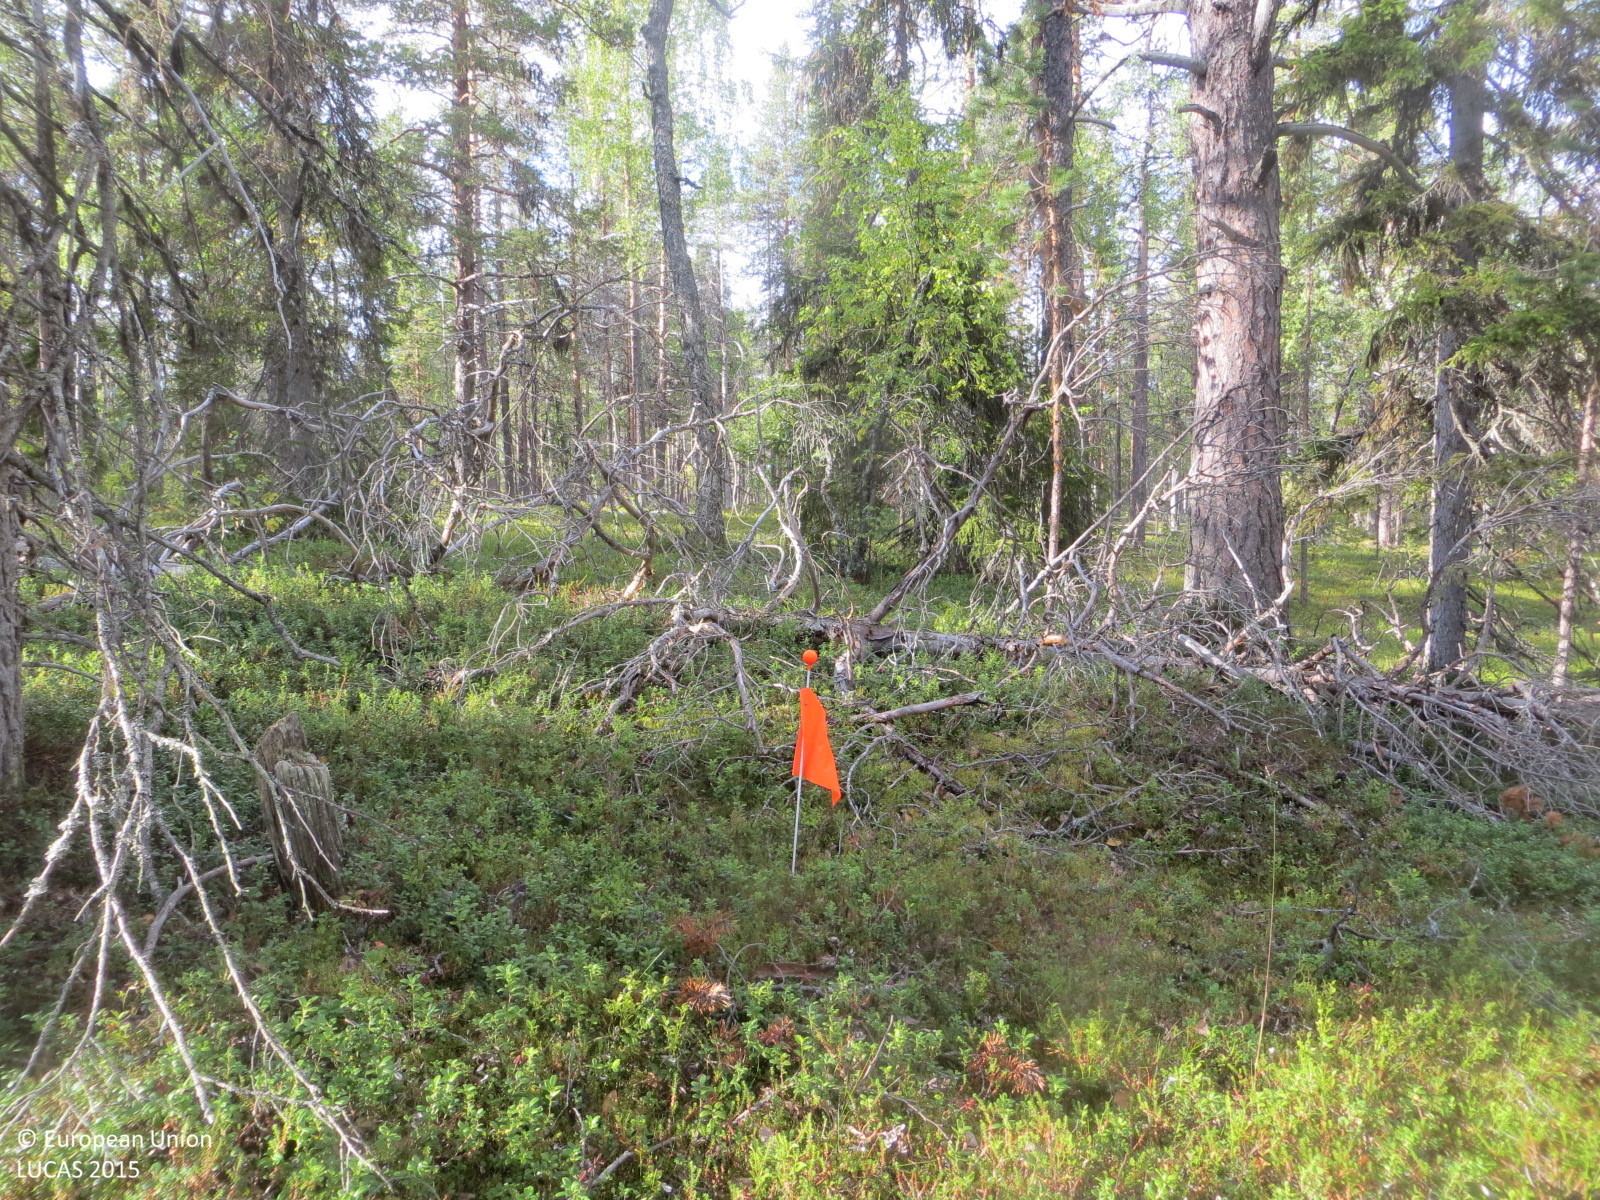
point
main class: Woodland
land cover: Other coniferous woodland
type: boreal forest
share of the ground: 50 - 75 %
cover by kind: coniferous forest trees 50 %, shrubs 50 %
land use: Semi-natural and natural areas not in use
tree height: > 5 m
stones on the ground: < 10 %
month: September
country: FI
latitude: 67.9583
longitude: 24.0332
